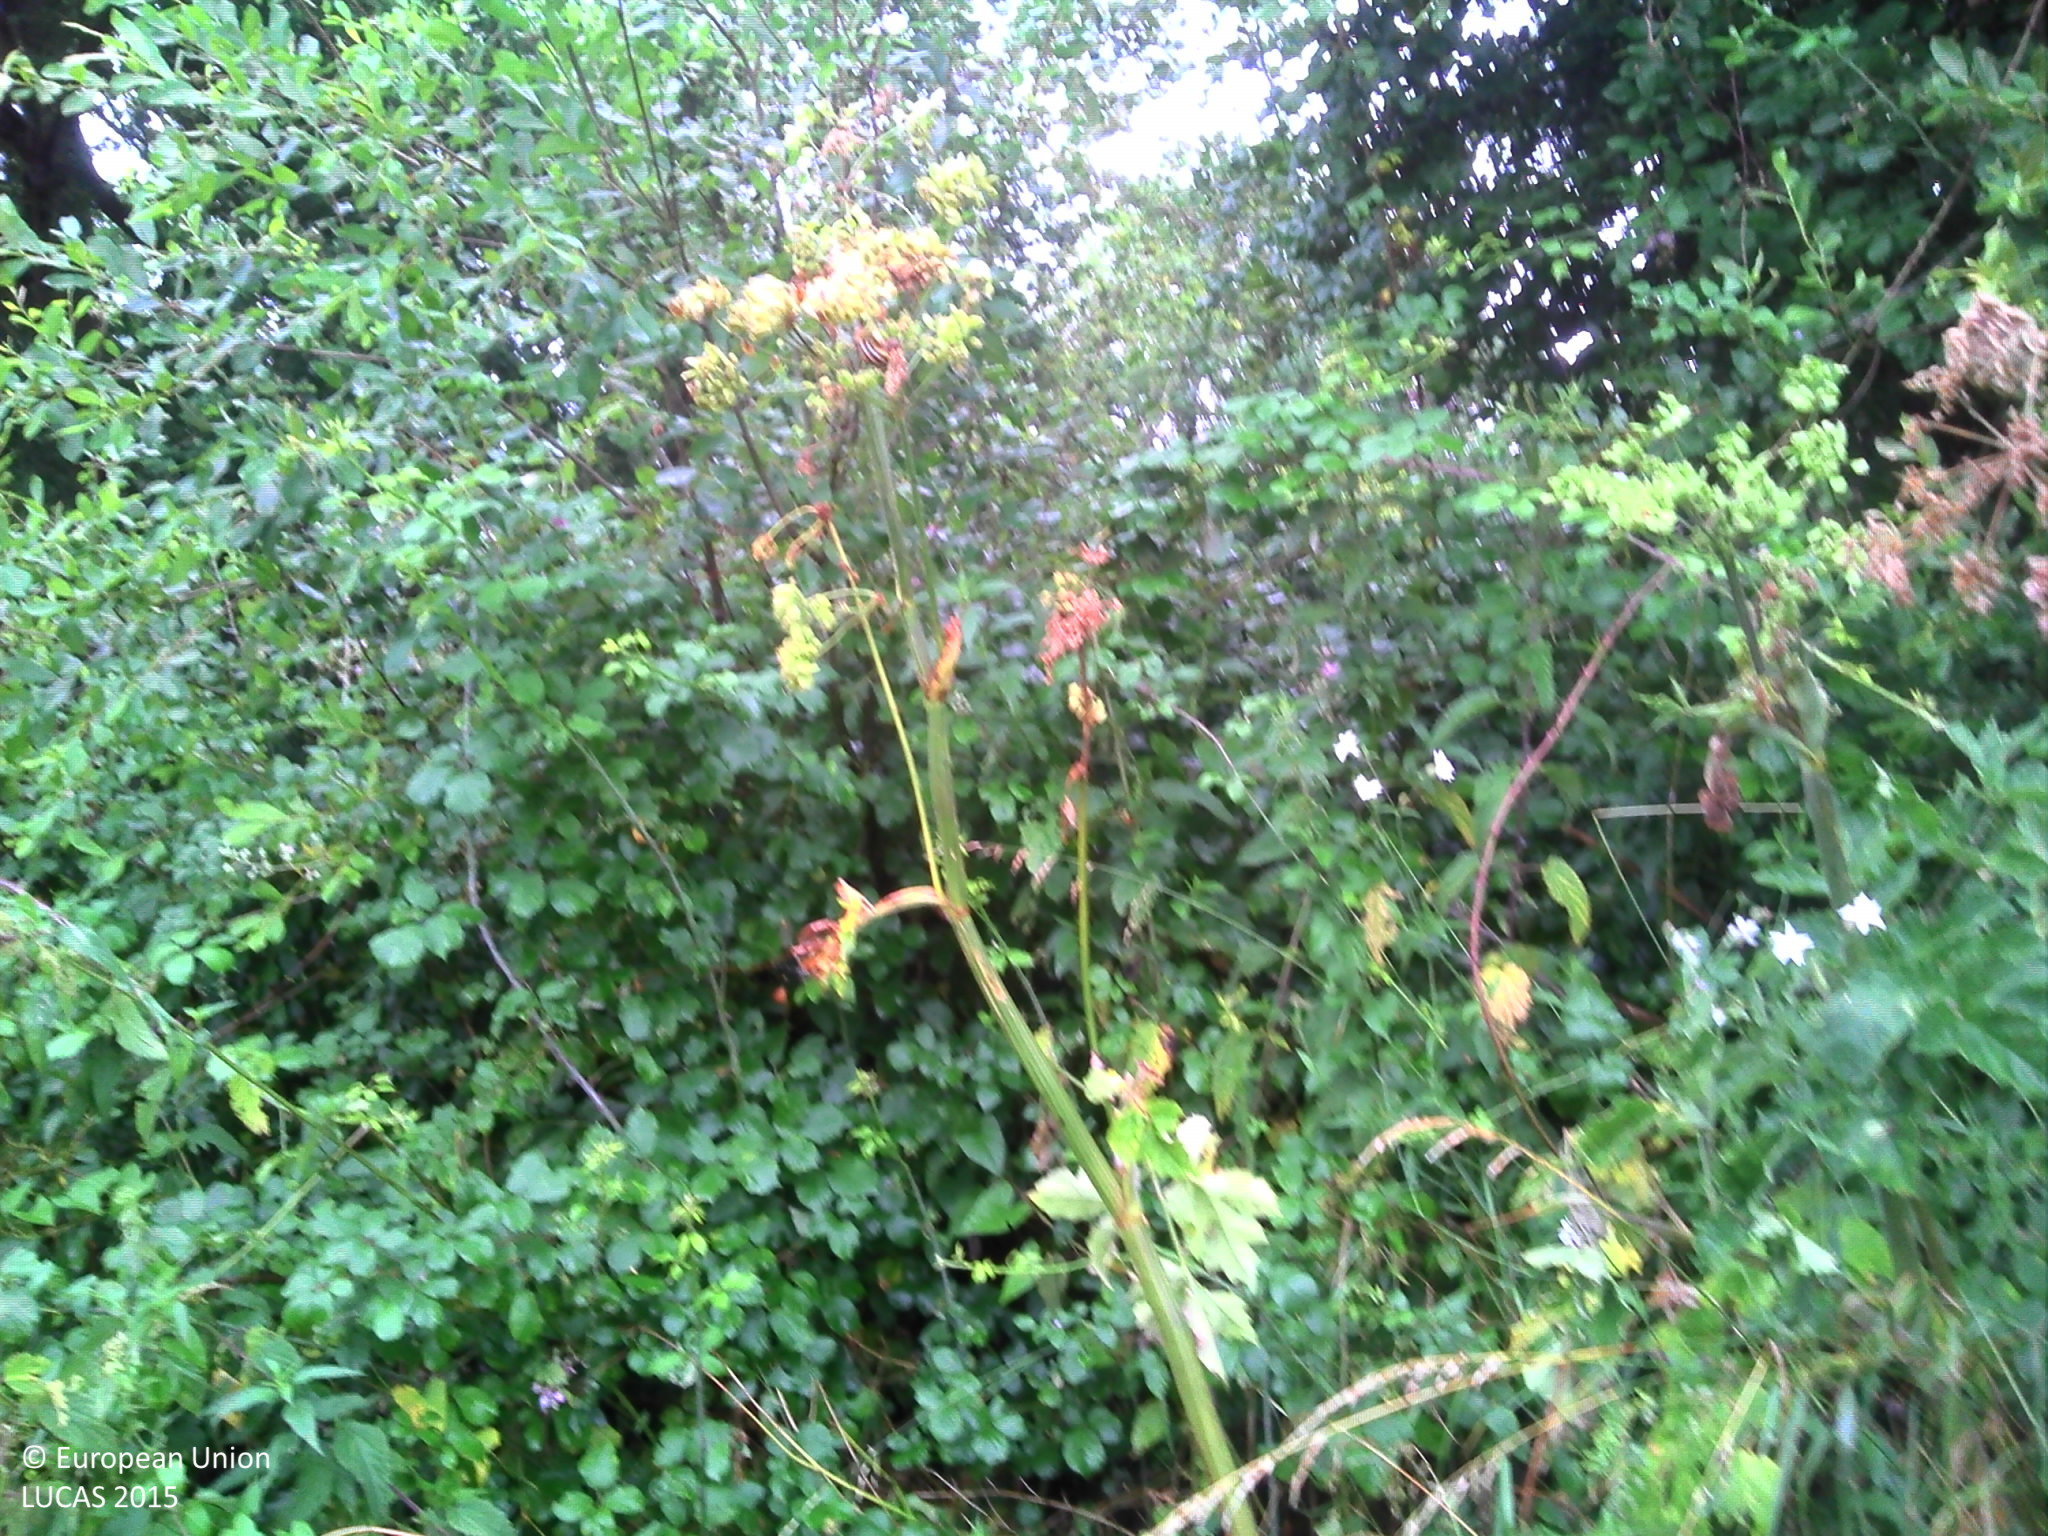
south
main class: Shrubland
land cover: Shrubland with sparse tree cover
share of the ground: > 75 %
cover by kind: shrubs 95 %, broadleaved forest trees 5 %
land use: Road transport
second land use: Semi-natural and natural areas not in use
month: July
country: FR
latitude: 47.1988
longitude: -1.8602
